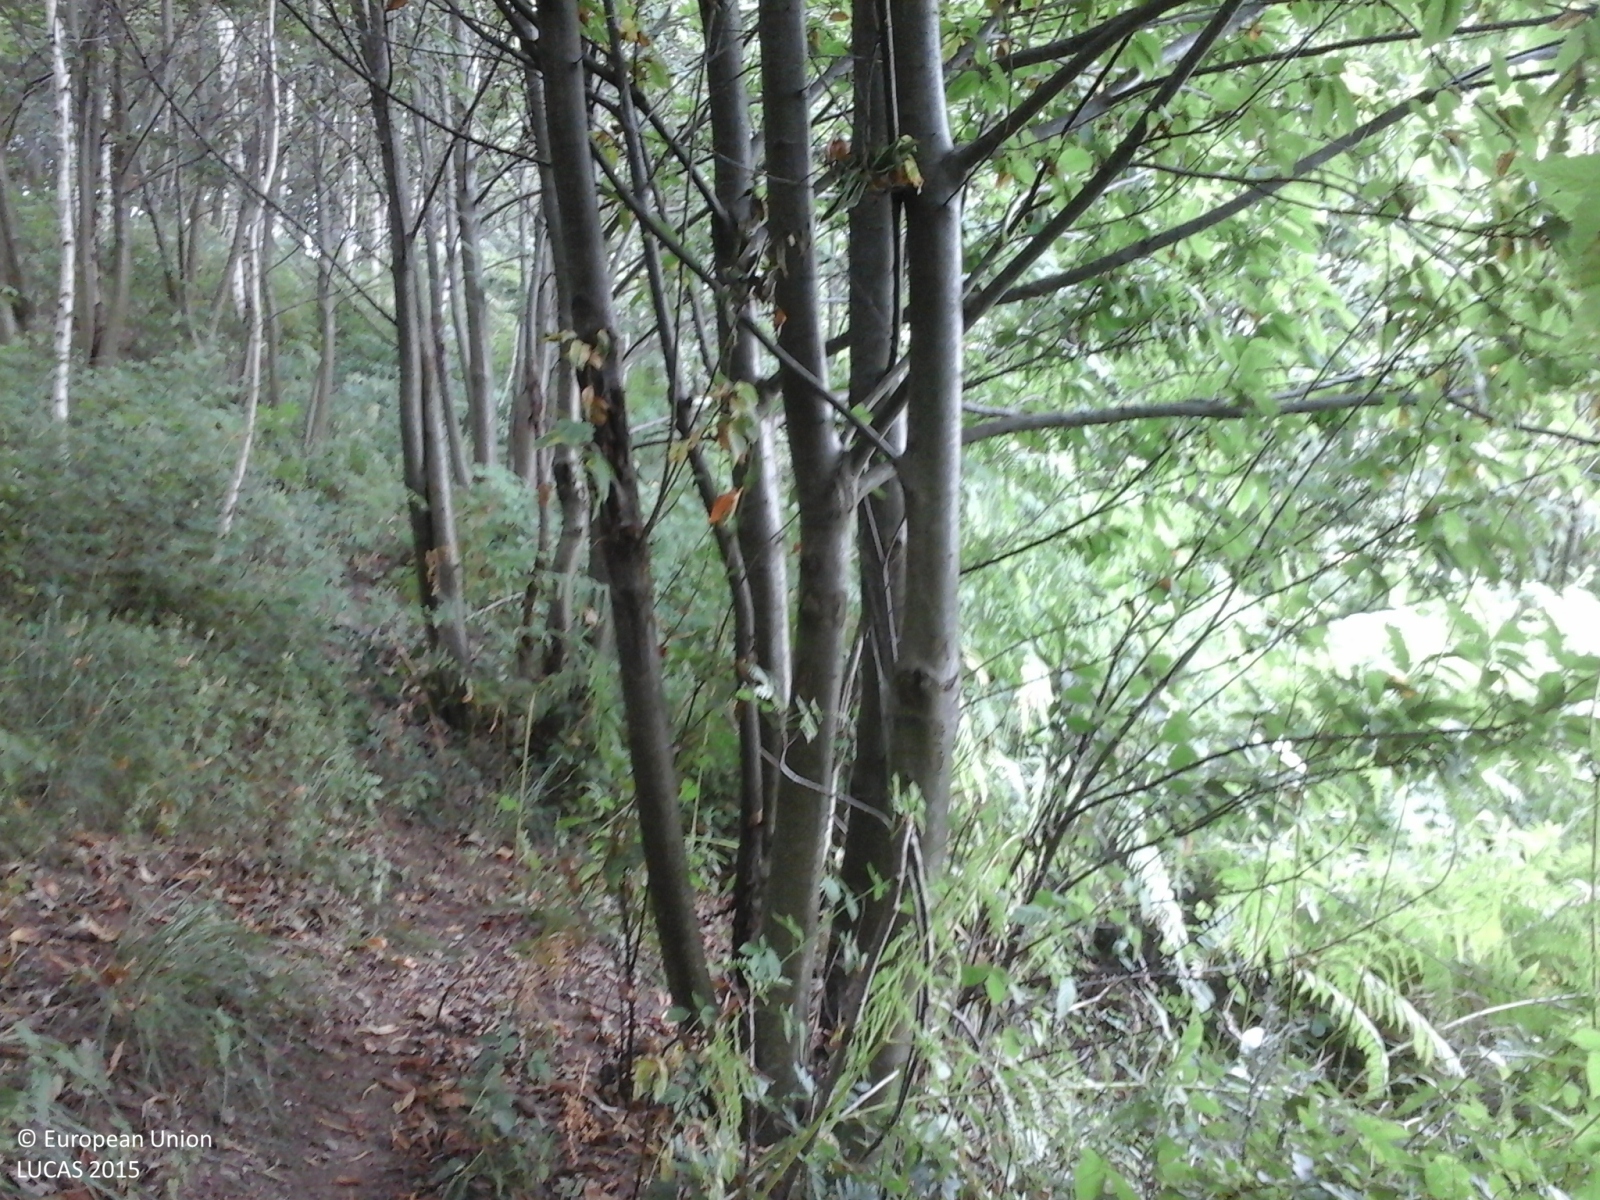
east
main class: Woodland
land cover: Broadleaved woodland
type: thermophilous deciduous forest
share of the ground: > 75 %
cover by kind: broadleaved forest trees 100 %
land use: Semi-natural and natural areas not in use
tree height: > 5 m
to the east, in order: Broadleaved woodland; Electric lines; Broadleaved woodland
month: July
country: IT
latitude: 45.4436
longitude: 7.7151
